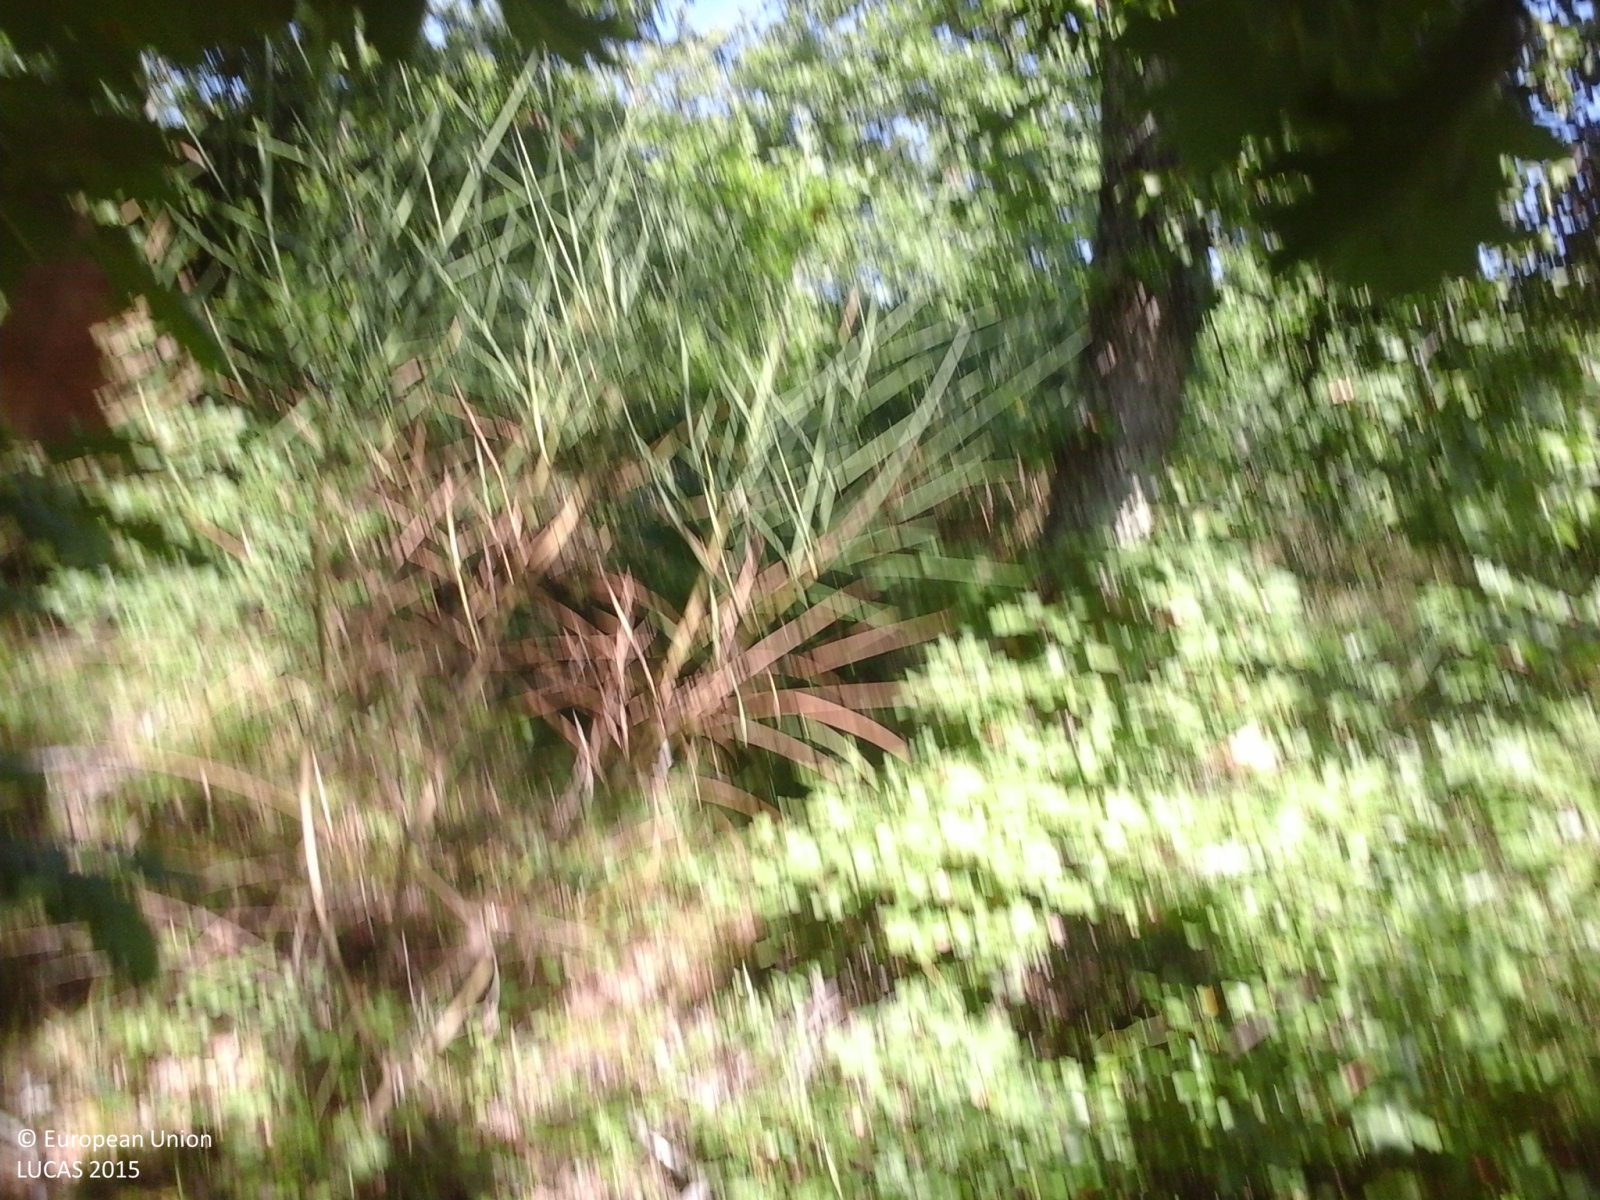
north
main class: Shrubland
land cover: Shrubland with sparse tree cover
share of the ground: > 75 %
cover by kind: shrubs 70 %, herbaceous plants 25 %, broadleaved forest trees 5 %
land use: Semi-natural and natural areas not in use
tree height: > 5 m
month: August
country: IT
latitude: 42.7137
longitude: 11.5943
